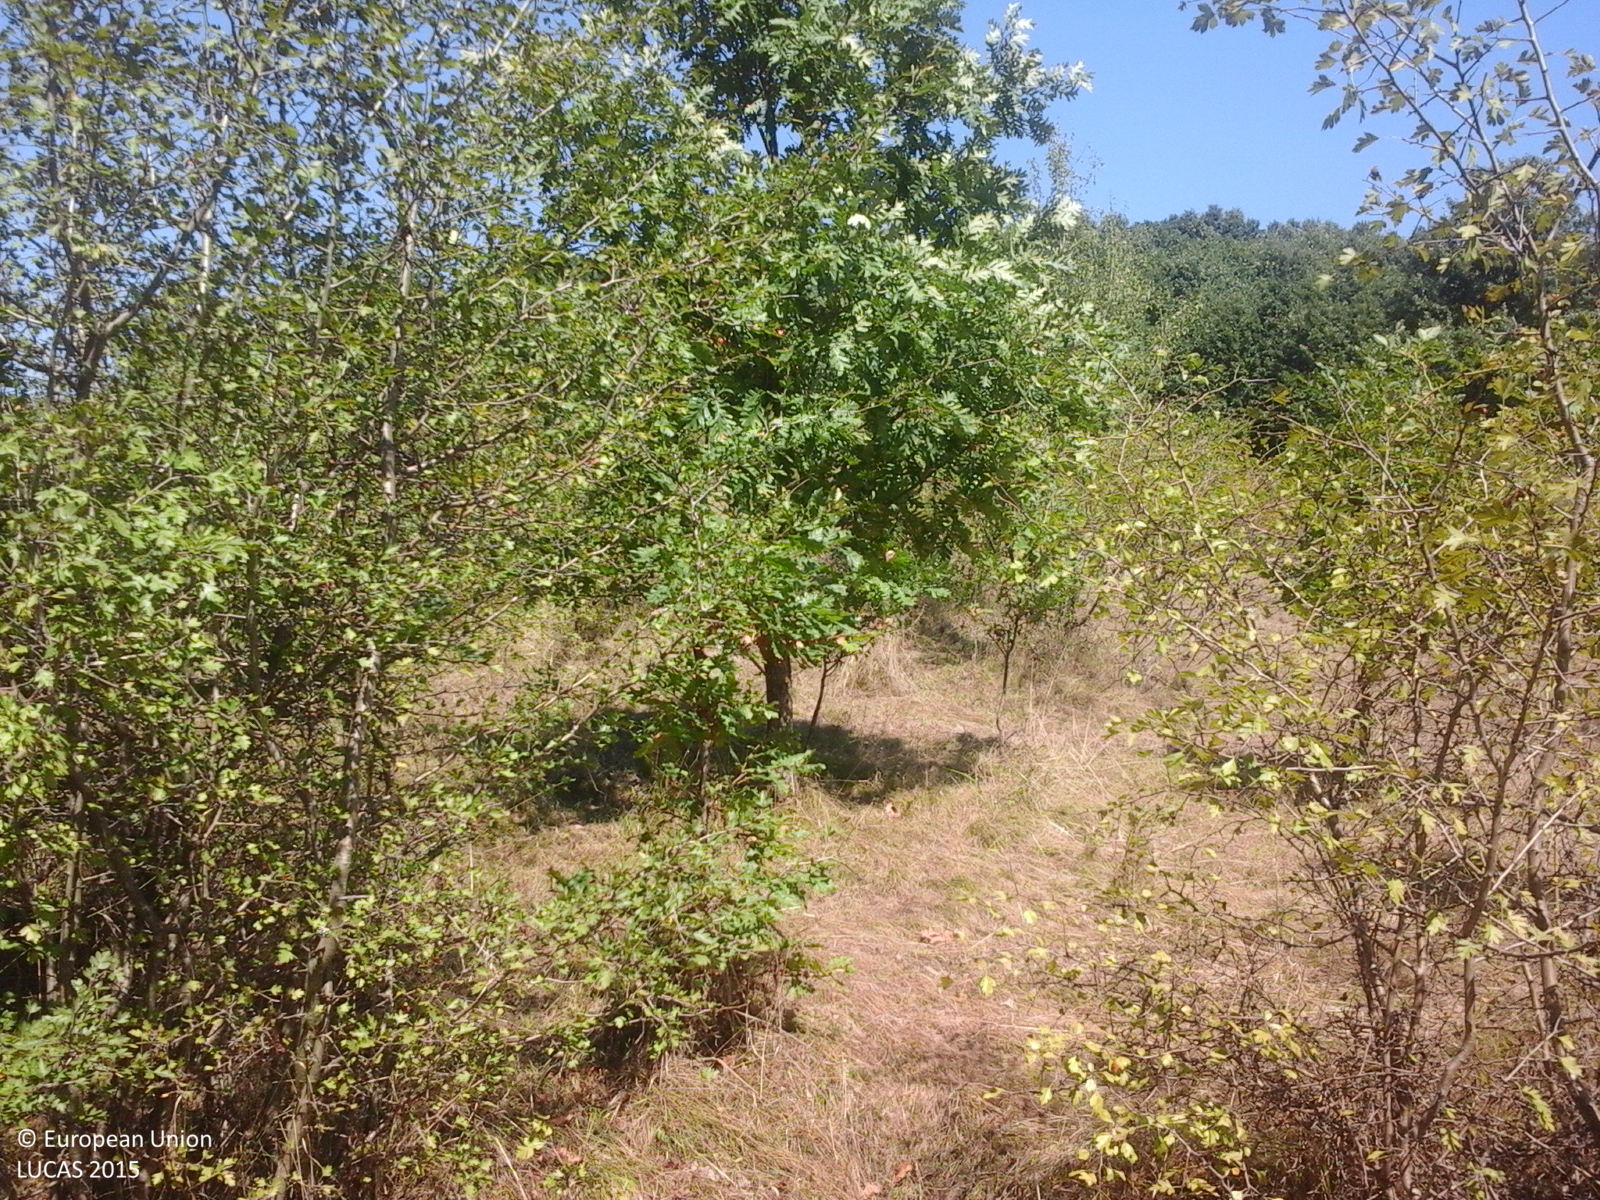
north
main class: Shrubland
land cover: Shrubland with sparse tree cover
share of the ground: > 75 %
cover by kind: shrubs 85 %, herbaceous plants 10 %, broadleaved forest trees 5 %
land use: Agriculture (excluding fallow land and kitchen gardens)
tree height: < 5 m
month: August
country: RO
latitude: 45.9512
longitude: 21.7914
